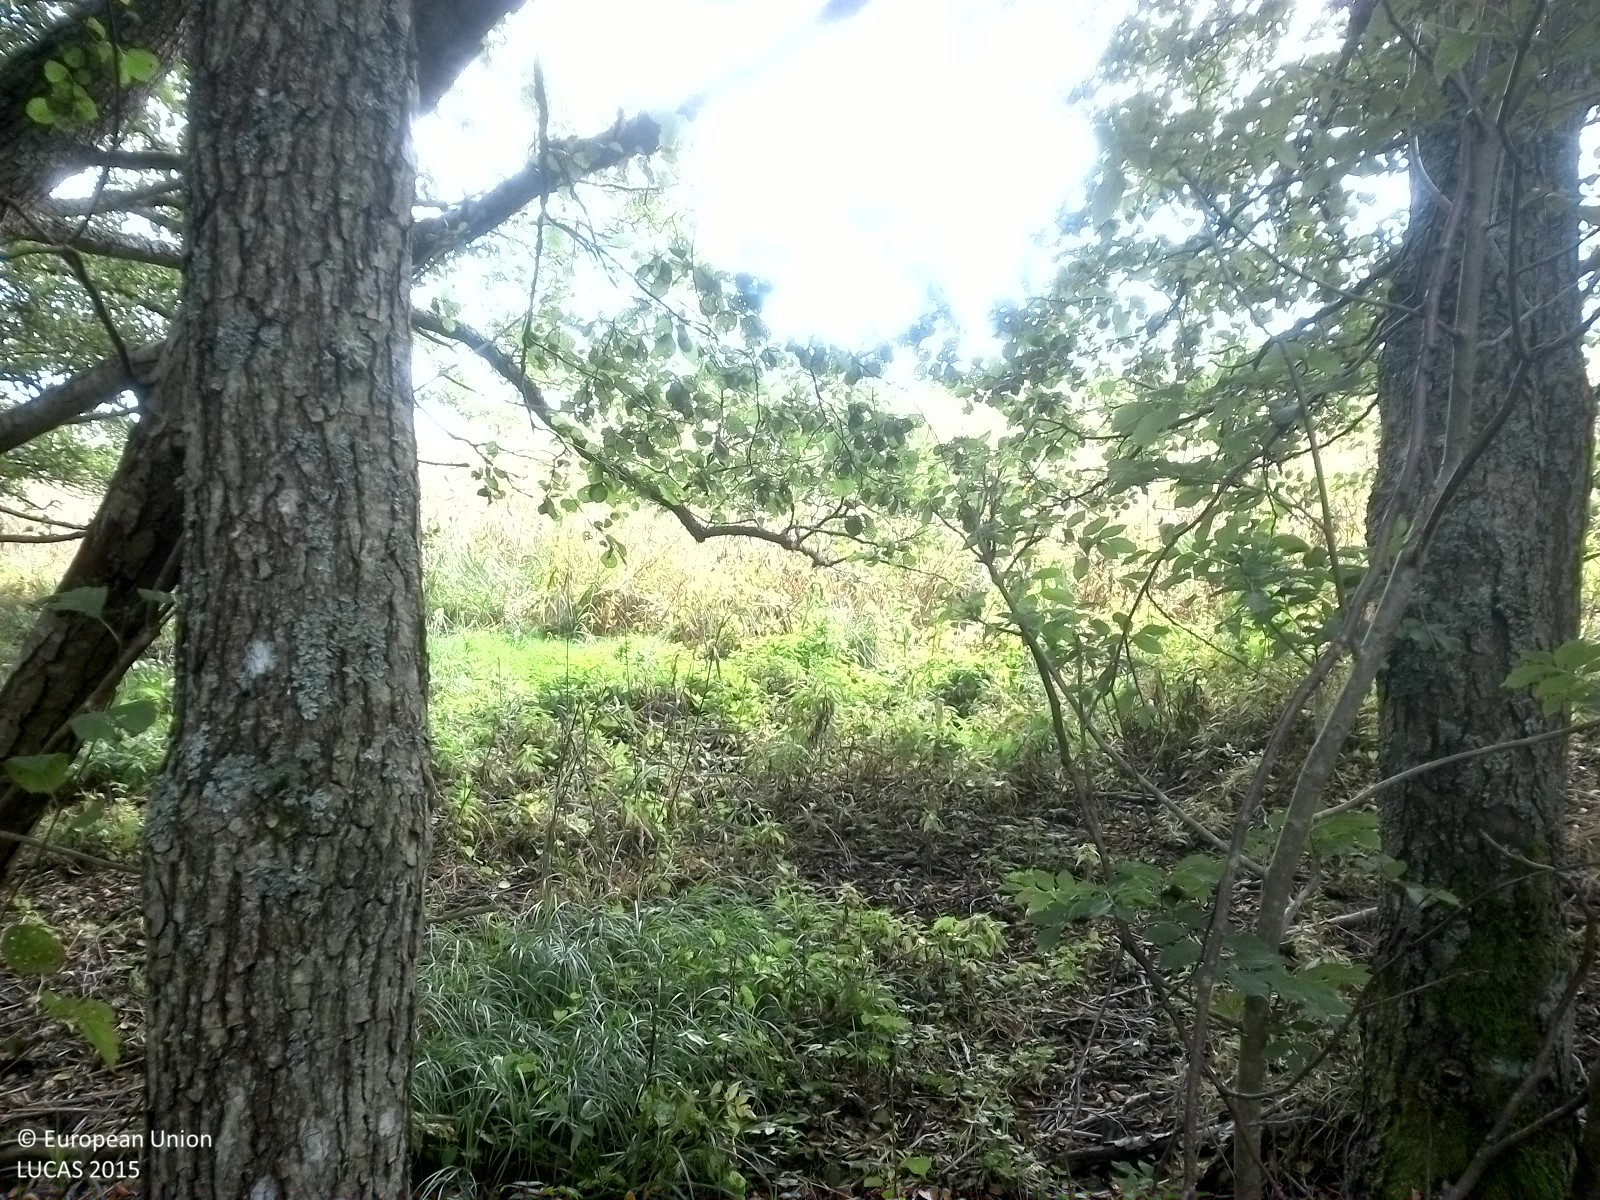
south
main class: Woodland
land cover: Broadleaved woodland
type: hemiboreal forest and nemoral coniferous forest and mixed broadleaved-coniferous forest
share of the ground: 25 - 50 %
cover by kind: broadleaved forest trees 40 %, herbaceous plants 40 %, unconsolidated bare surface 10 %, coniferous forest trees 5 %, shrubs 5 %
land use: Semi-natural and natural areas not in use
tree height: > 5 m
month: September
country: SE
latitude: 58.4320
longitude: 16.6932
